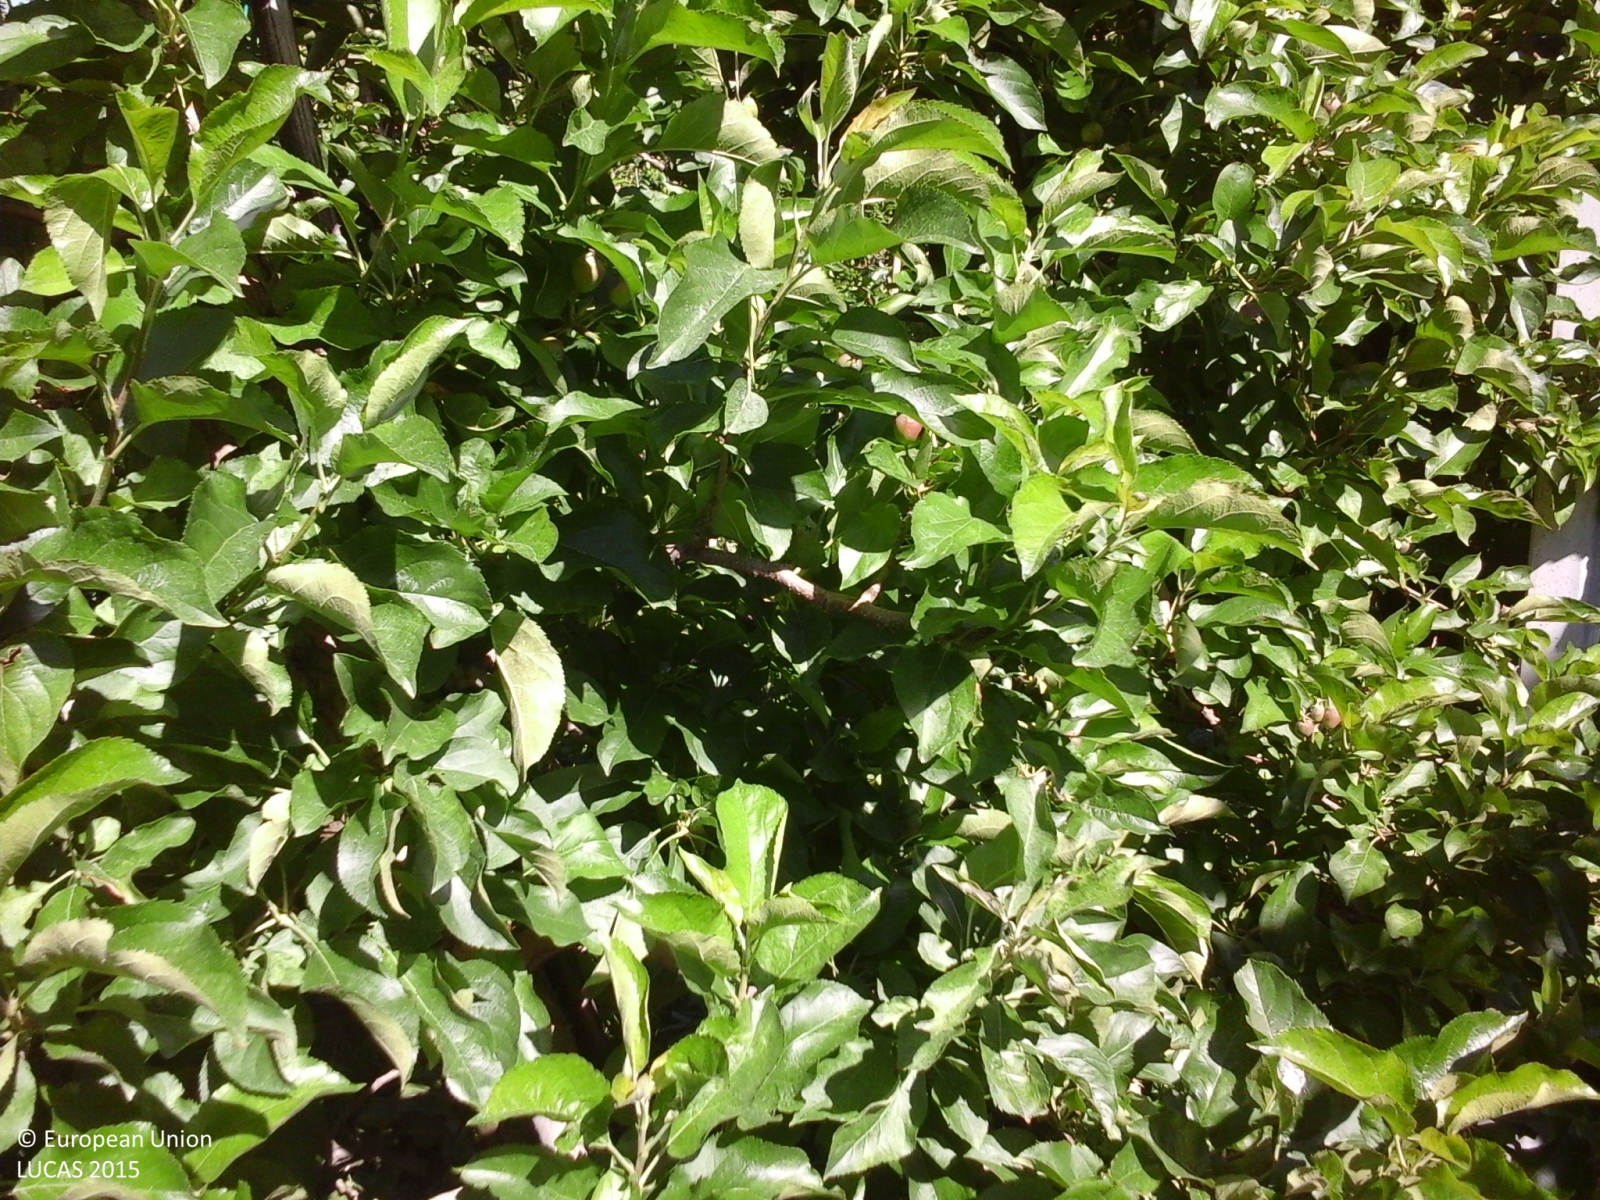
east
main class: Cropland
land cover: Apple fruit
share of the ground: > 75 %
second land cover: Grassland without tree/shrub cover
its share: > 75 %
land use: Agriculture (excluding fallow land and kitchen gardens)
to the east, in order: Apple fruit; Grassland without tree/shrub cover; Paved roads, cycling and walking lanes; Apple fruit; Tracks; Apple fruit; Paved roads, cycling and walking lanes; Apple fruit
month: May
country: IT
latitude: 46.6178
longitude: 10.8739
